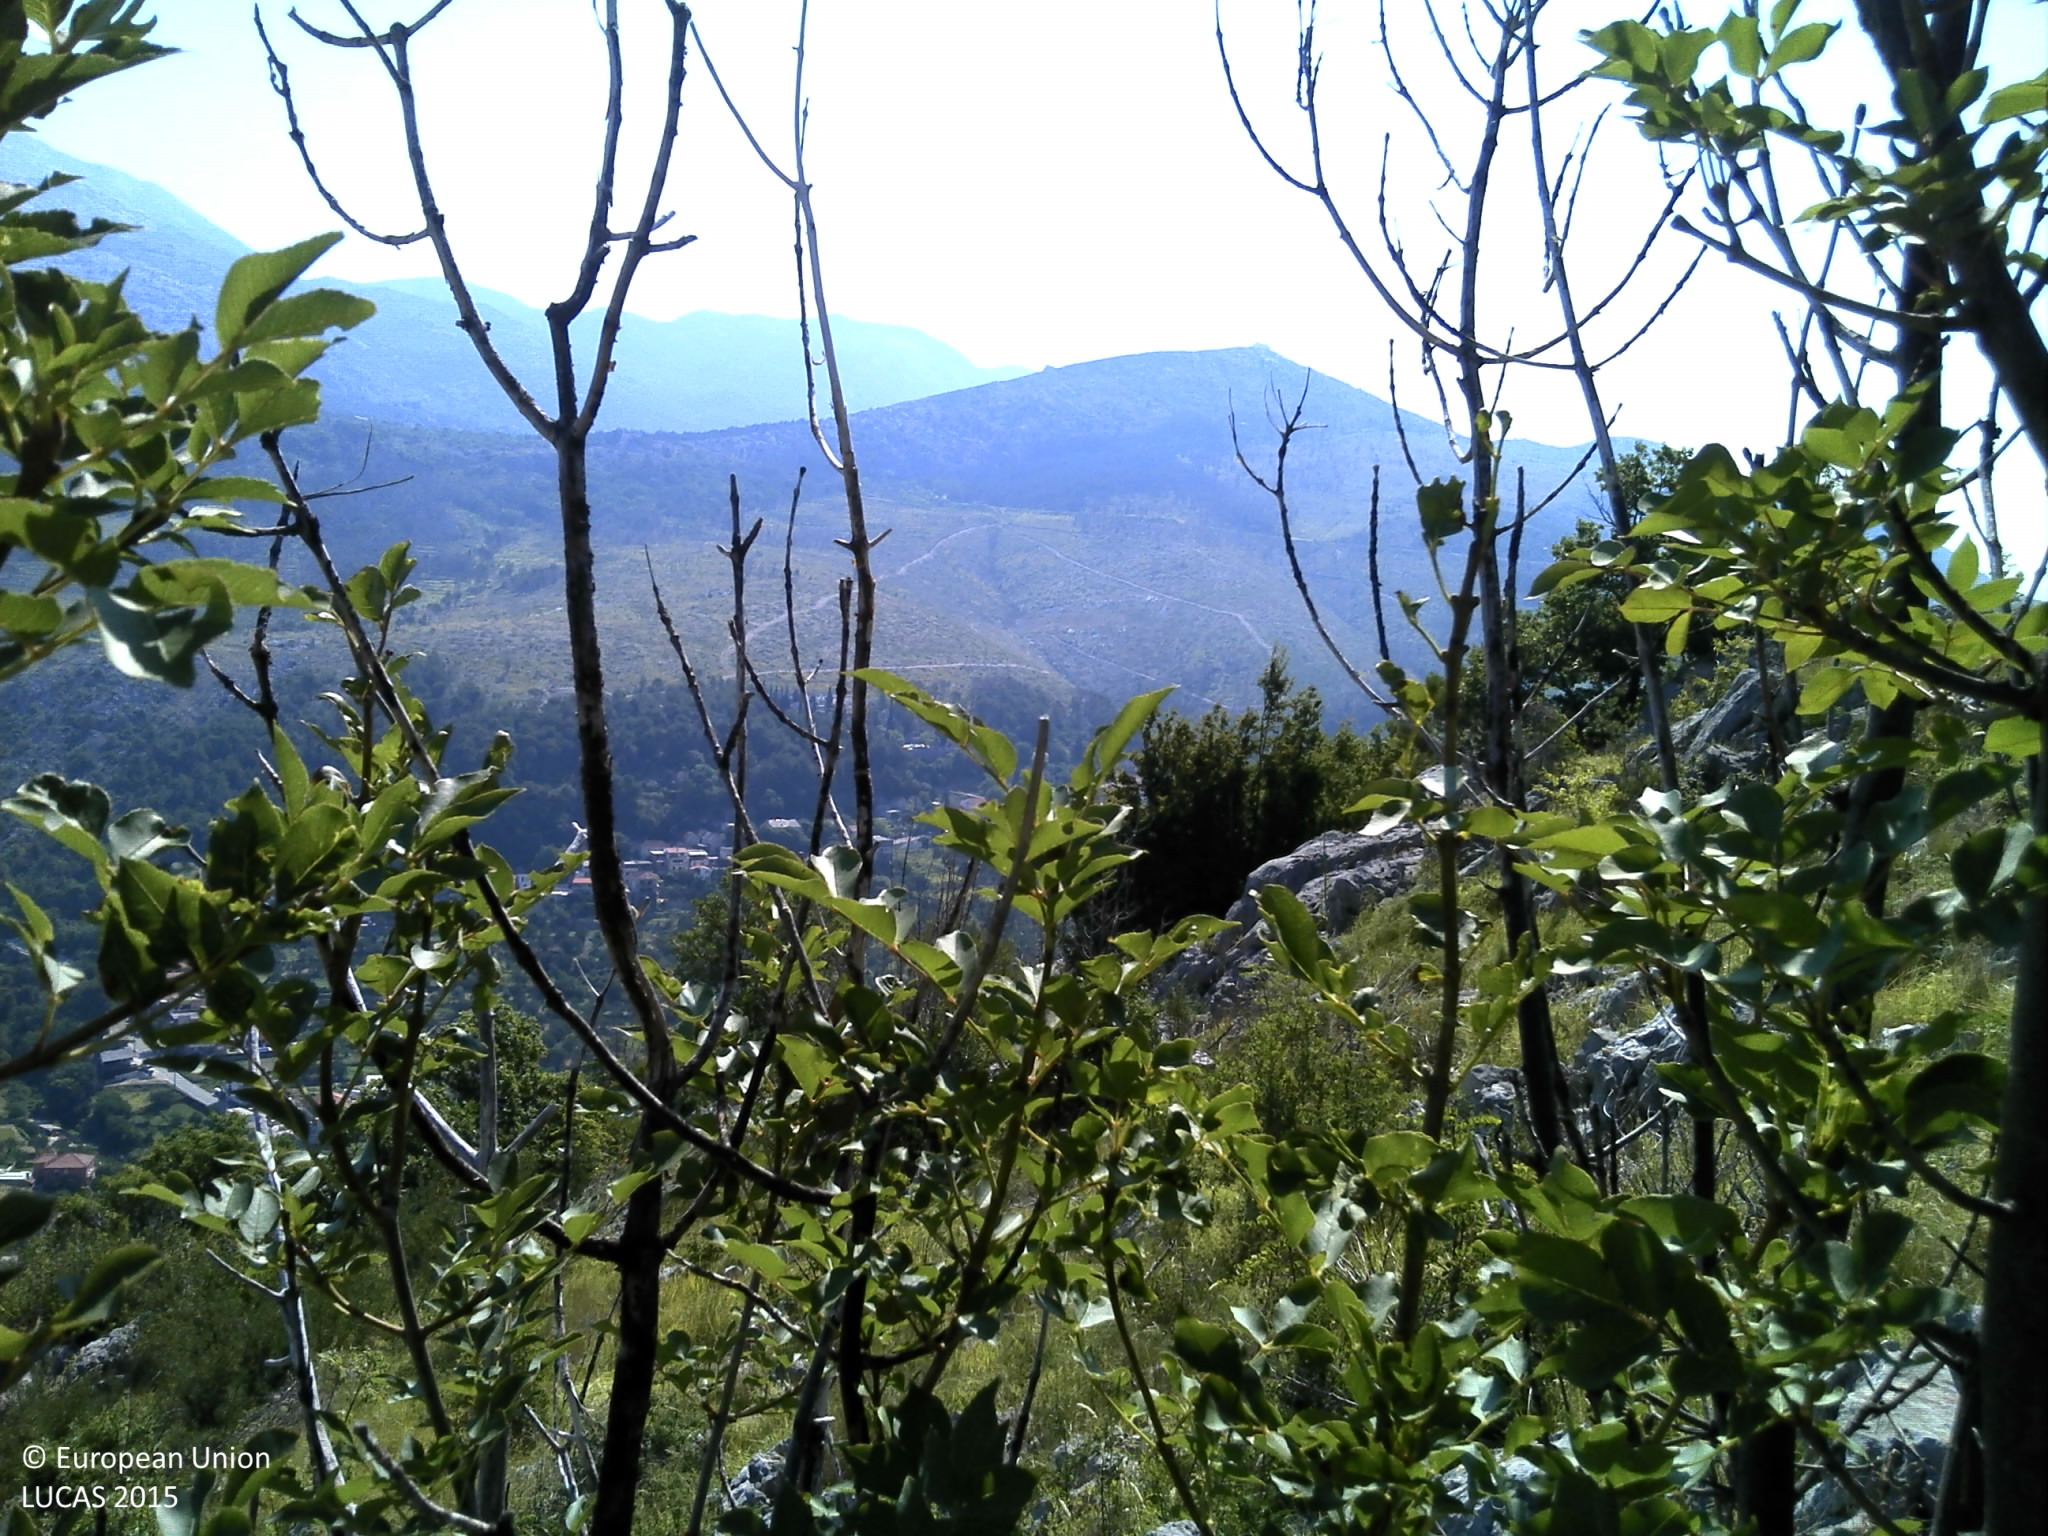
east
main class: Shrubland
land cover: Shrubland with sparse tree cover
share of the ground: 25 - 50 %
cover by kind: shrubs 30 %, herbaceous plants 30 %, unconsolidated bare surface 20 %, consolidated bare surface 10 %, coniferous forest trees 5 %, lichens and mosses 5 %
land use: Semi-natural and natural areas not in use
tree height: < 5 m
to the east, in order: Shrubland with sparse tree cover; Rock outcrops; Shrubland with sparse tree cover; Dry stone walls; Shrubland with sparse tree cover
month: July
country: HR
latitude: 43.5080
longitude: 16.5837
